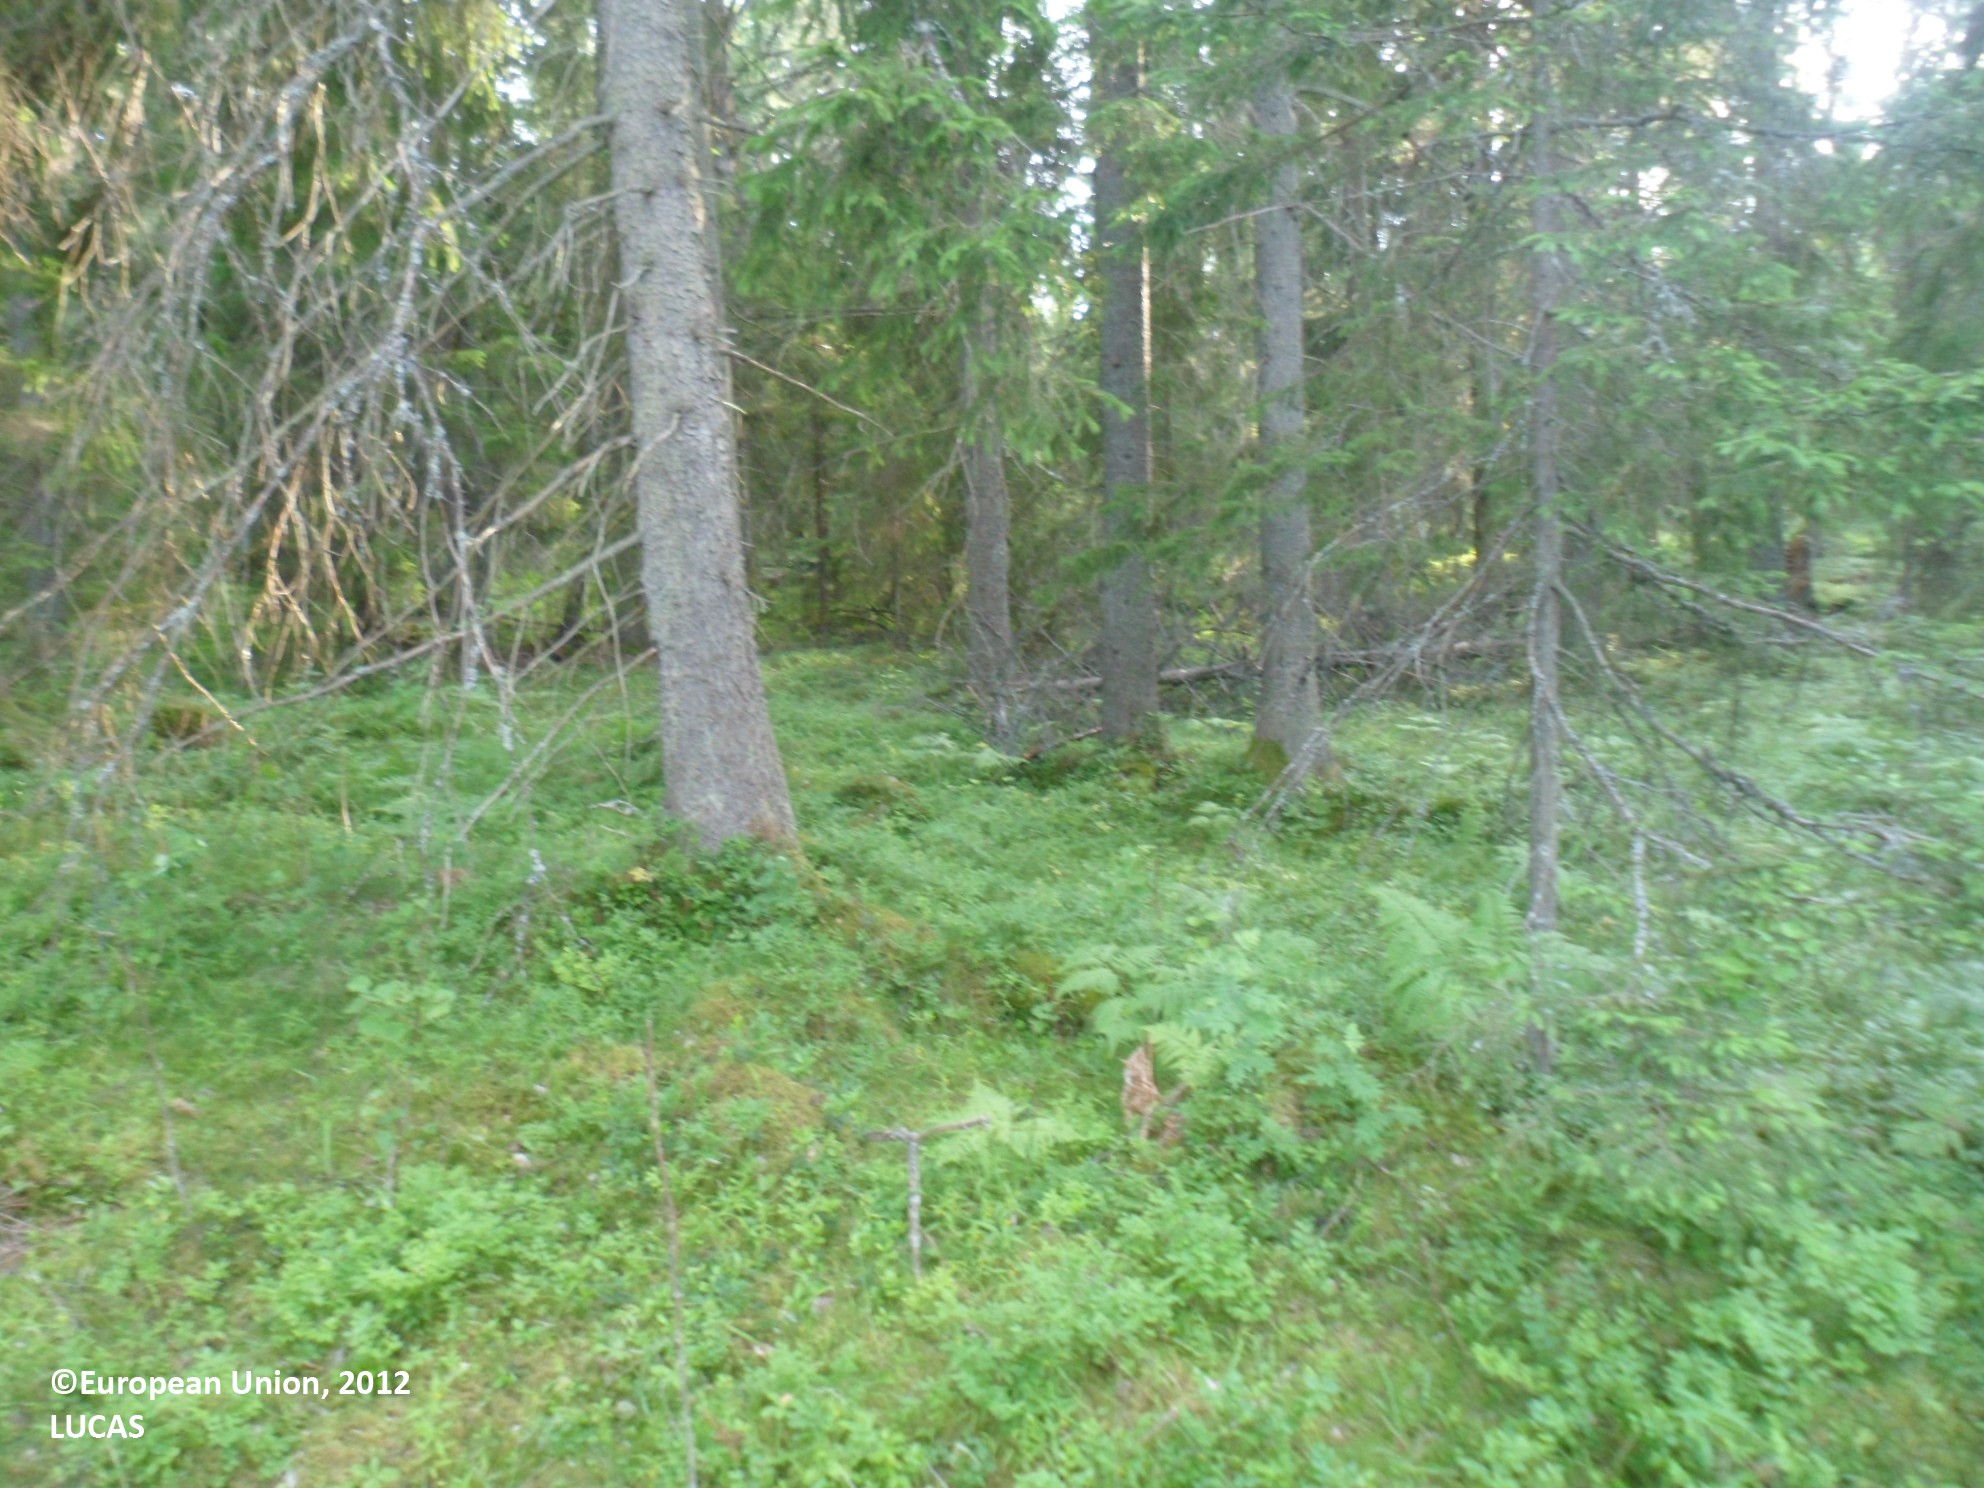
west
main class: Woodland
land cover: Spruce dominated coniferous woodland
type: boreal forest
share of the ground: > 75 %
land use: Forestry
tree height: > 5 m
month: July
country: SE
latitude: 59.6457
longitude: 18.6043
